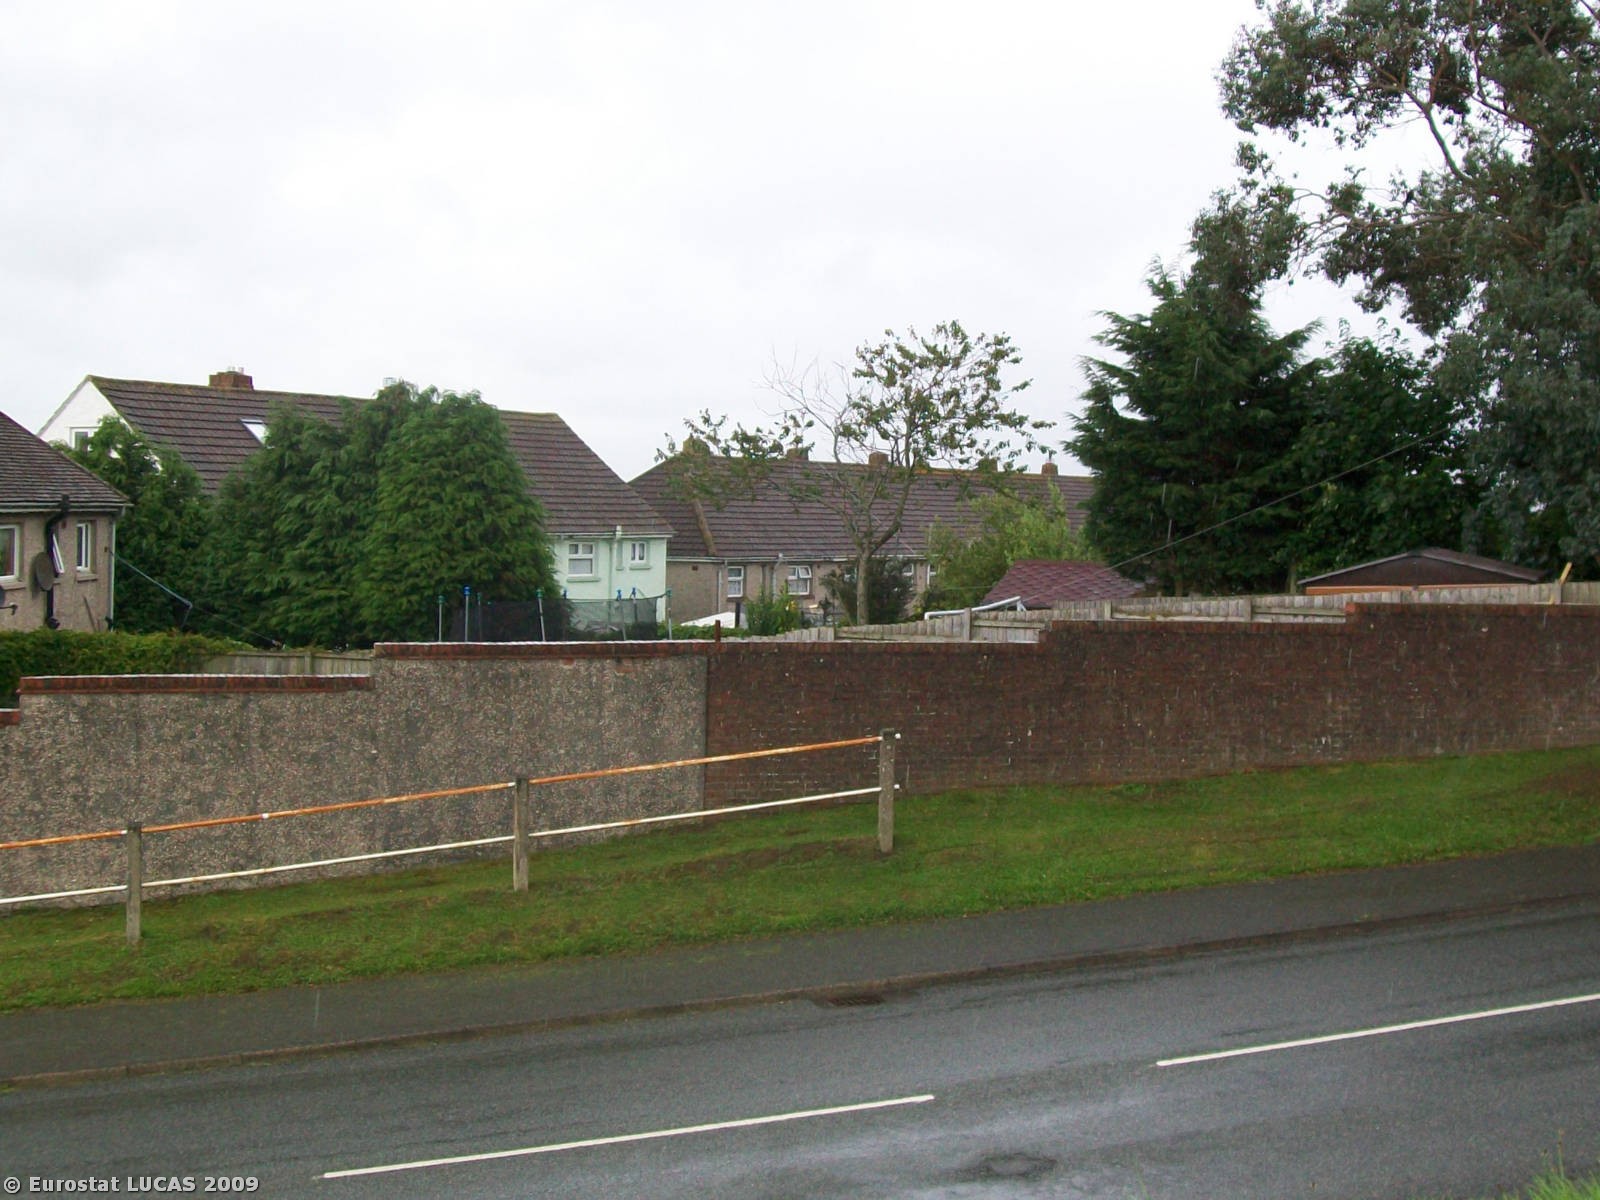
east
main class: Artificial land
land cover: Non built-up linear features
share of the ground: > 75 %
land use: Road transport
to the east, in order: Non built-up linear features; Grassland without tree/shrub cover; Paved roads, cycling and walking lanes; Artificial constructions in urban areas; Grassland without tree/shrub cover; Tracks; Artificial constructions in urban areas; Paved roads, cycling and walking lanes
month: July
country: GB
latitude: 51.8035
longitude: -4.9815
